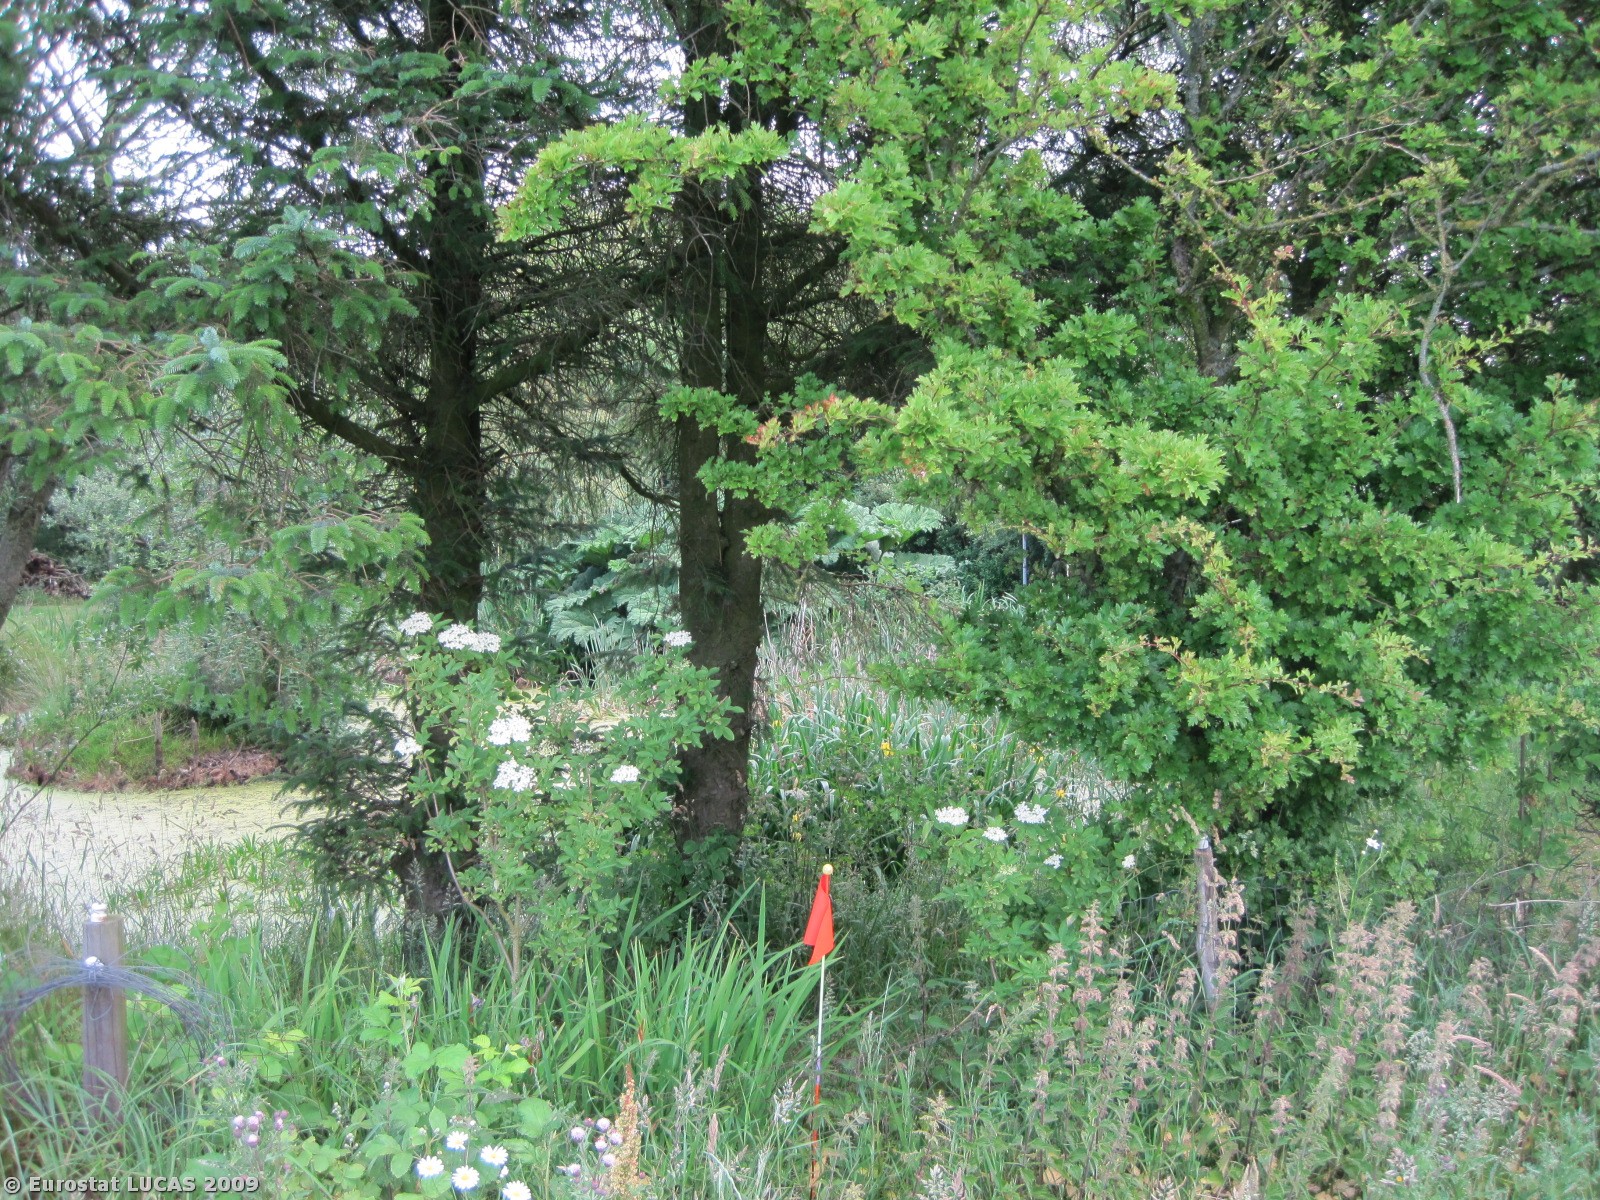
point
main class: Woodland
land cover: Mixed woodland
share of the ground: 50 - 75 %
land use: Residential
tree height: > 5 m
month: June
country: DK
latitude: 56.5557
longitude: 8.4239
